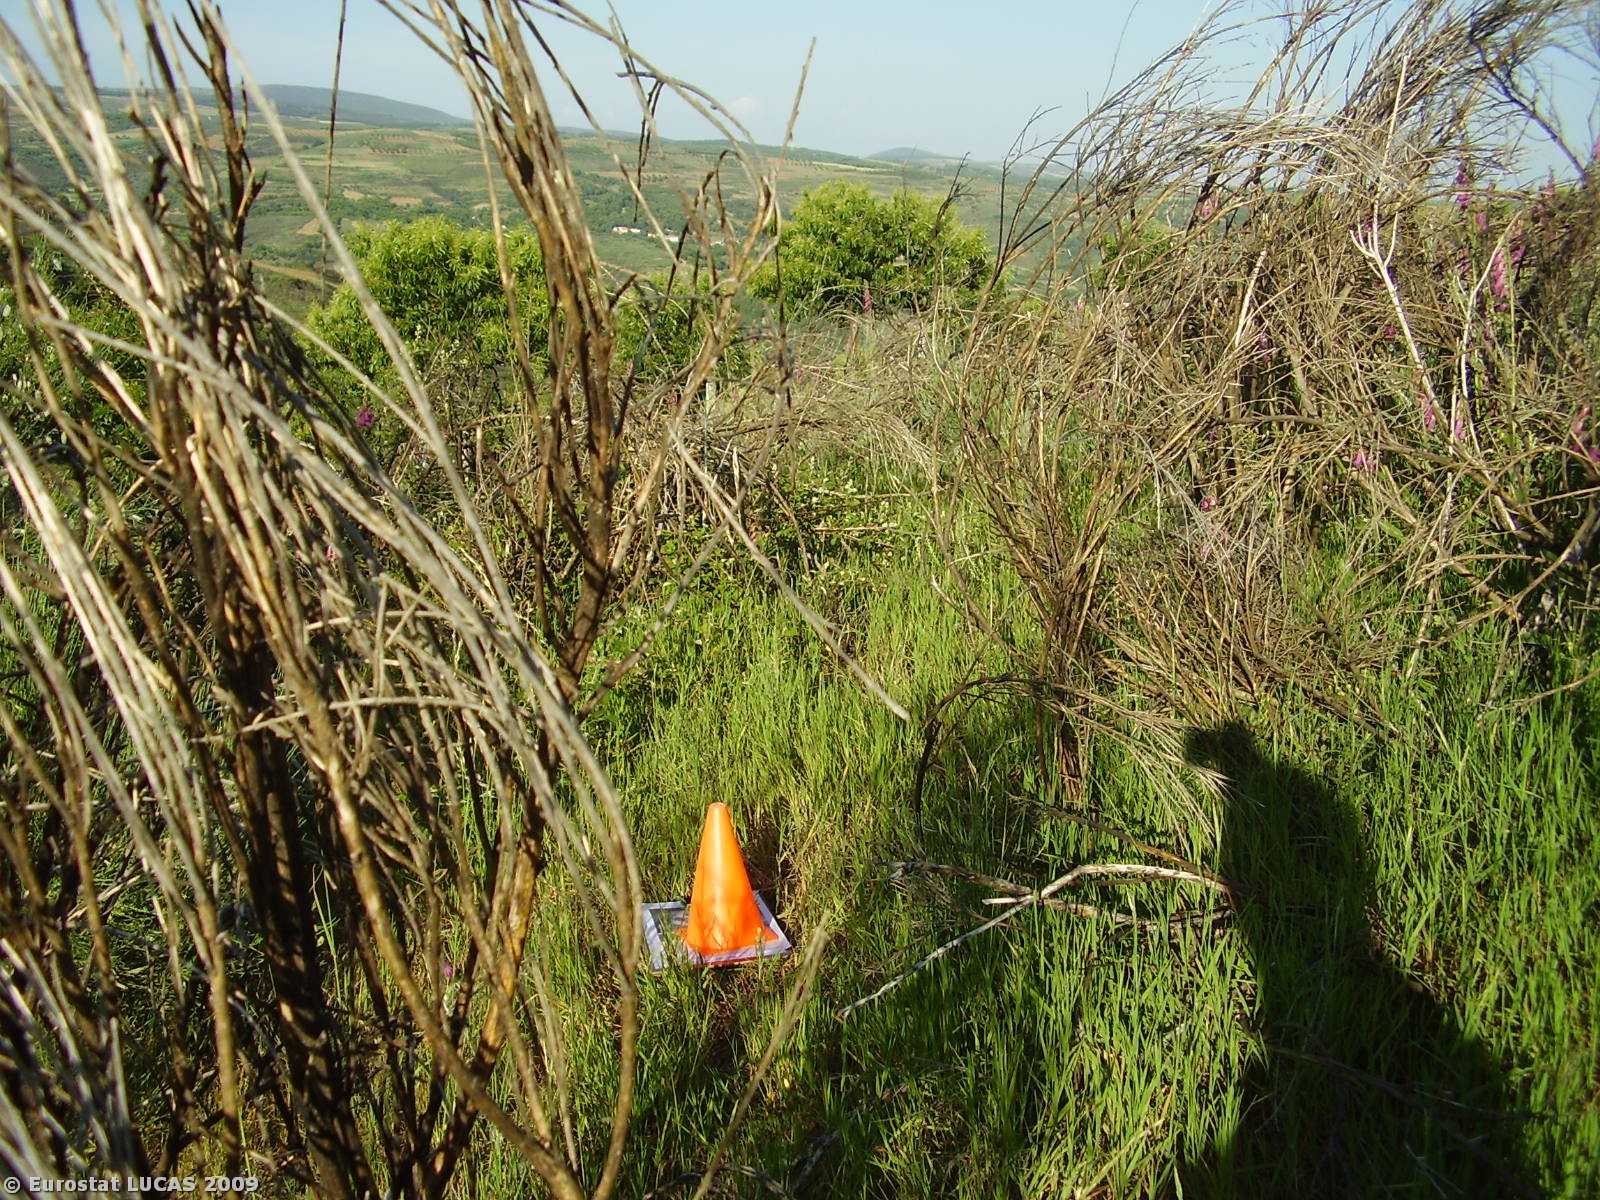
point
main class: Grassland
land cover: Spontaneously vegetated surfaces
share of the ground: > 75 %
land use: Nature reserves
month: June
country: PT
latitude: 41.9108
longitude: -6.9619
